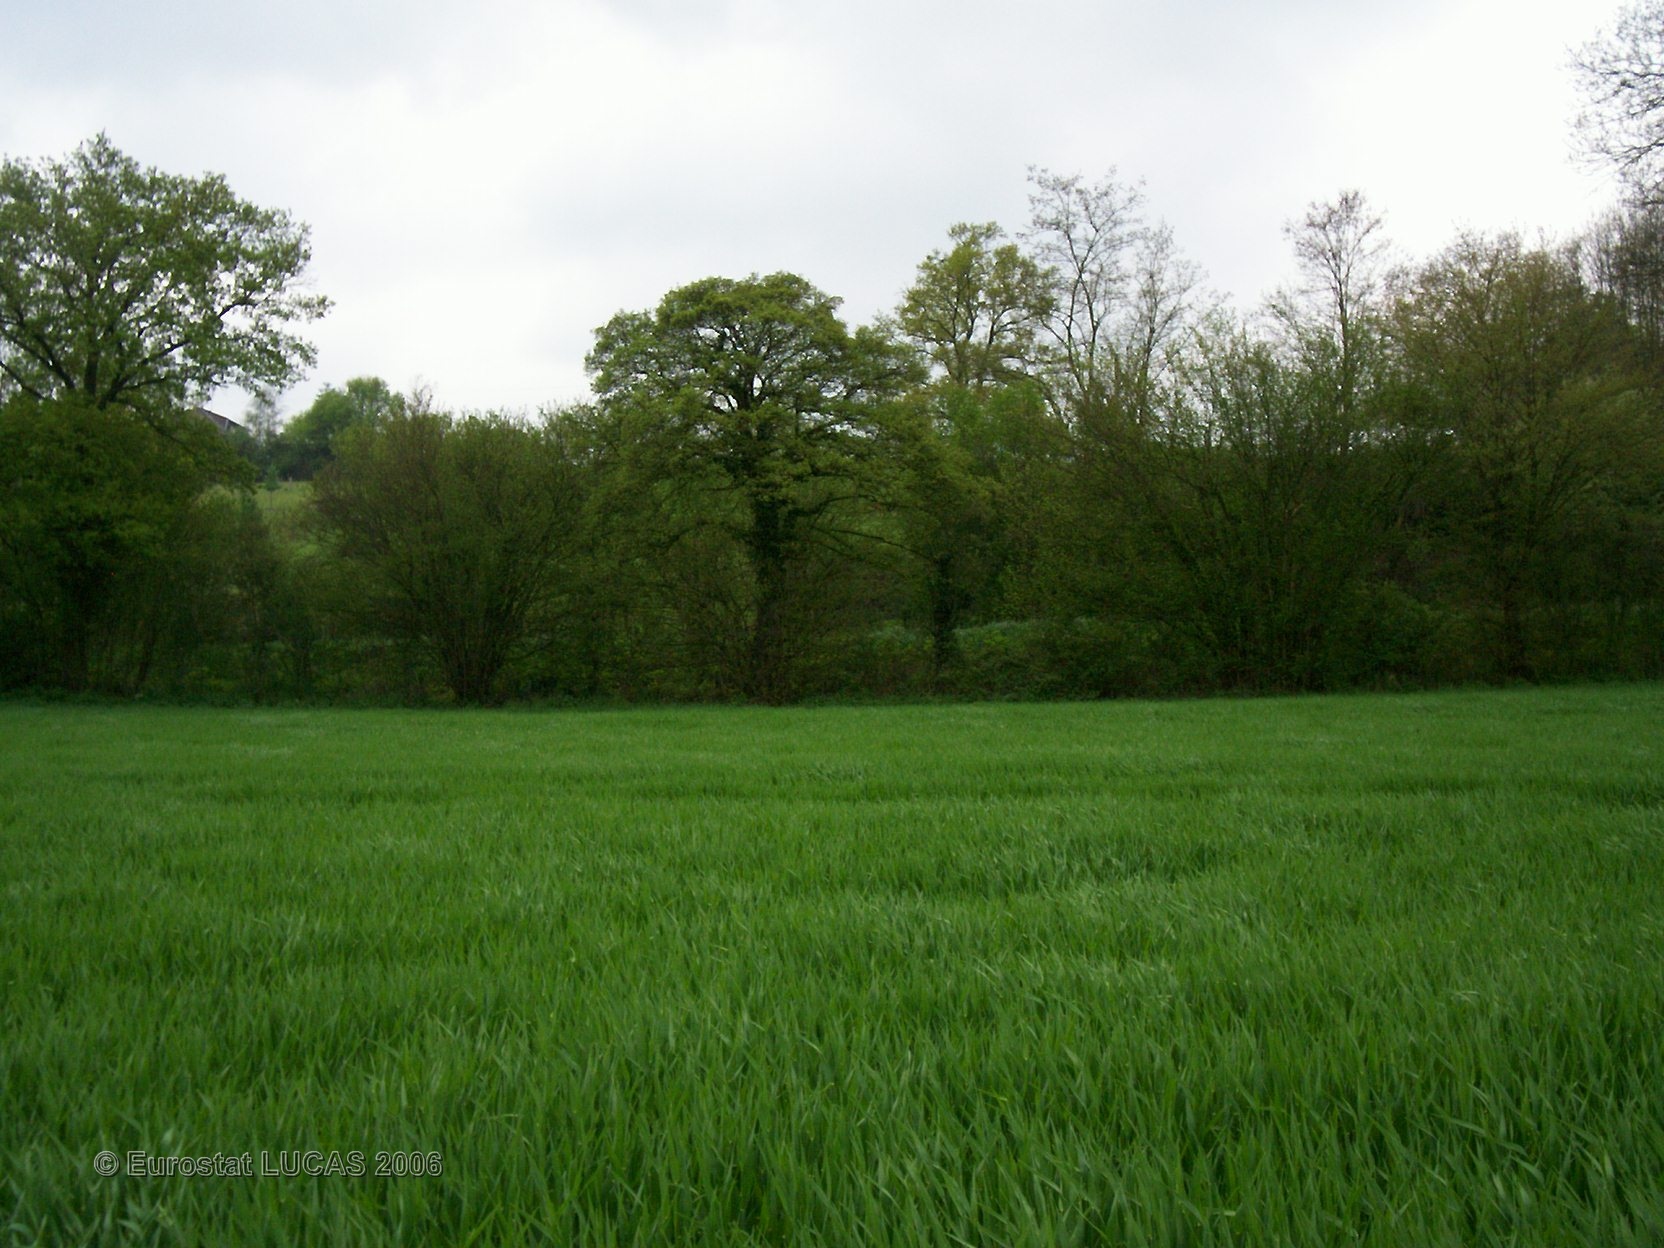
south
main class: Cropland
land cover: Barley
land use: Agriculture (excluding fallow land and kitchen gardens)
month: April
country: FR
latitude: 46.0979
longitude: 4.7898
